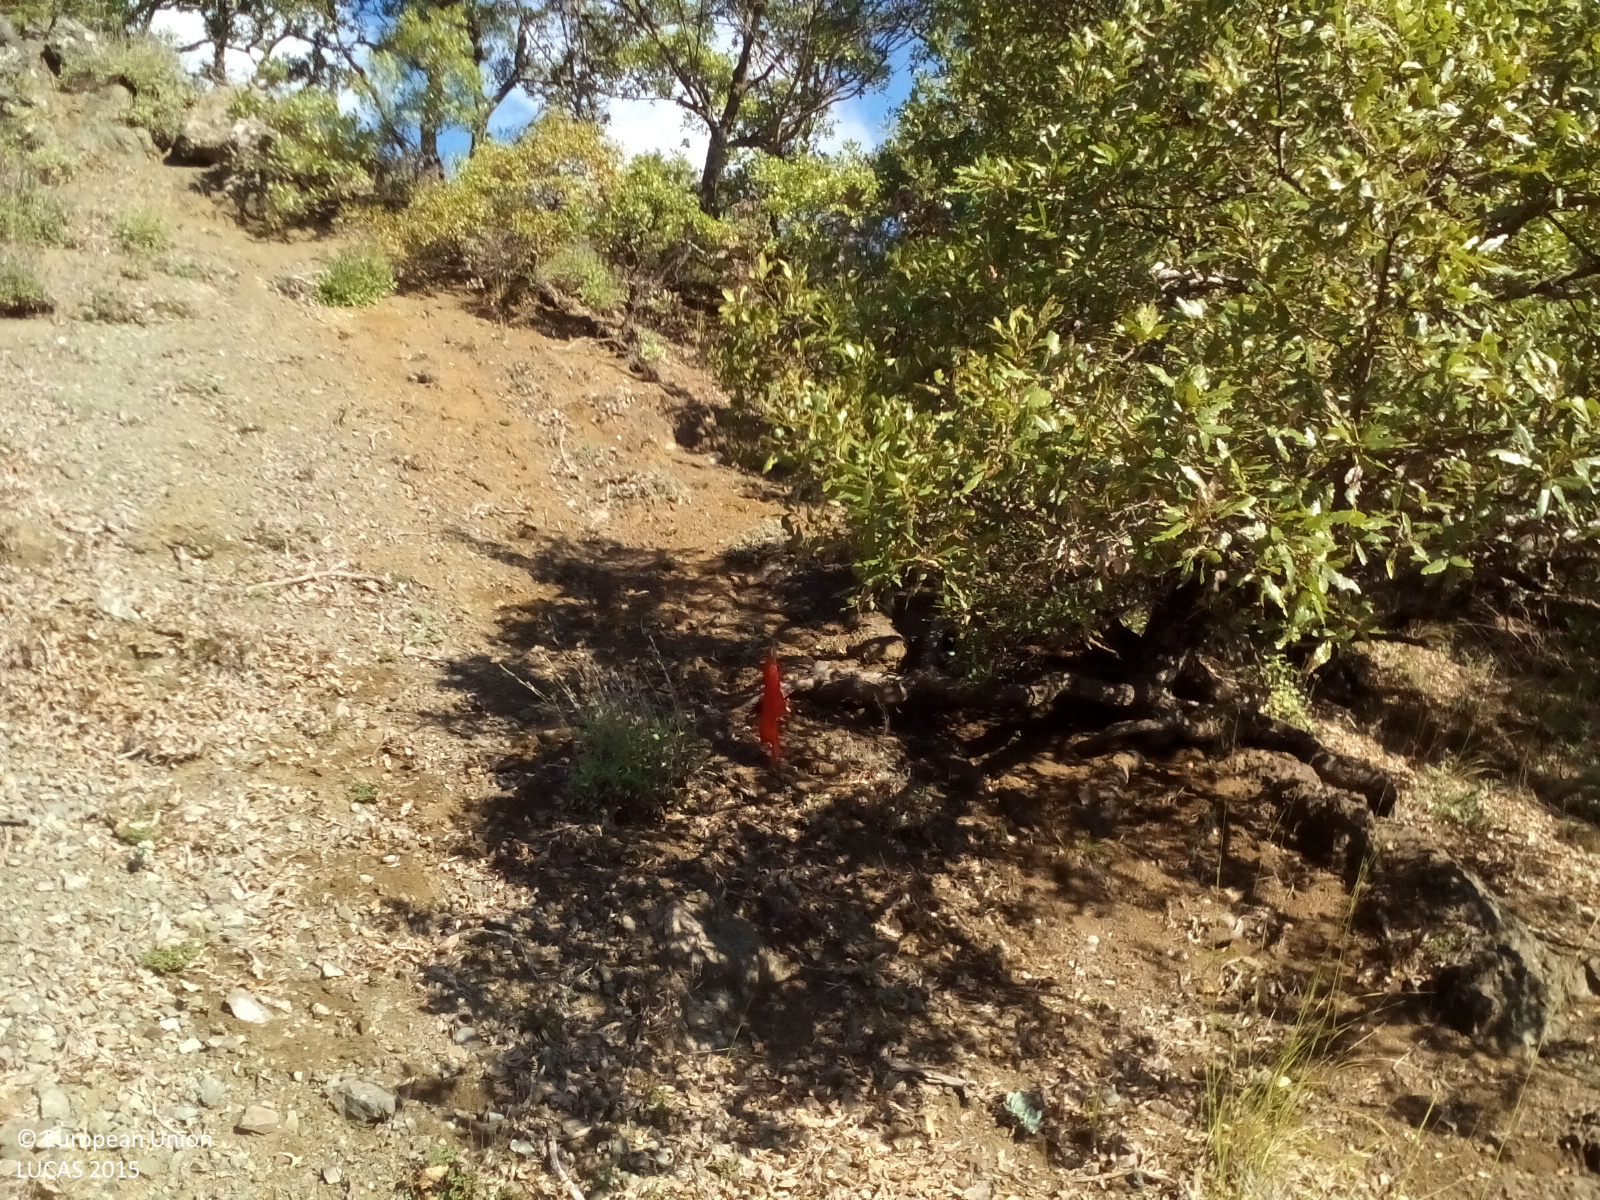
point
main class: Woodland
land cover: Broadleaved woodland
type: thermophilous deciduous forest
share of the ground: 25 - 50 %
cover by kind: broadleaved forest trees 45 %, unconsolidated bare surface 30 %, herbaceous plants 15 %, shrubs 10 %
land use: Forestry
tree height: > 5 m
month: September
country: GR
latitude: 39.9997
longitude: 21.2644
